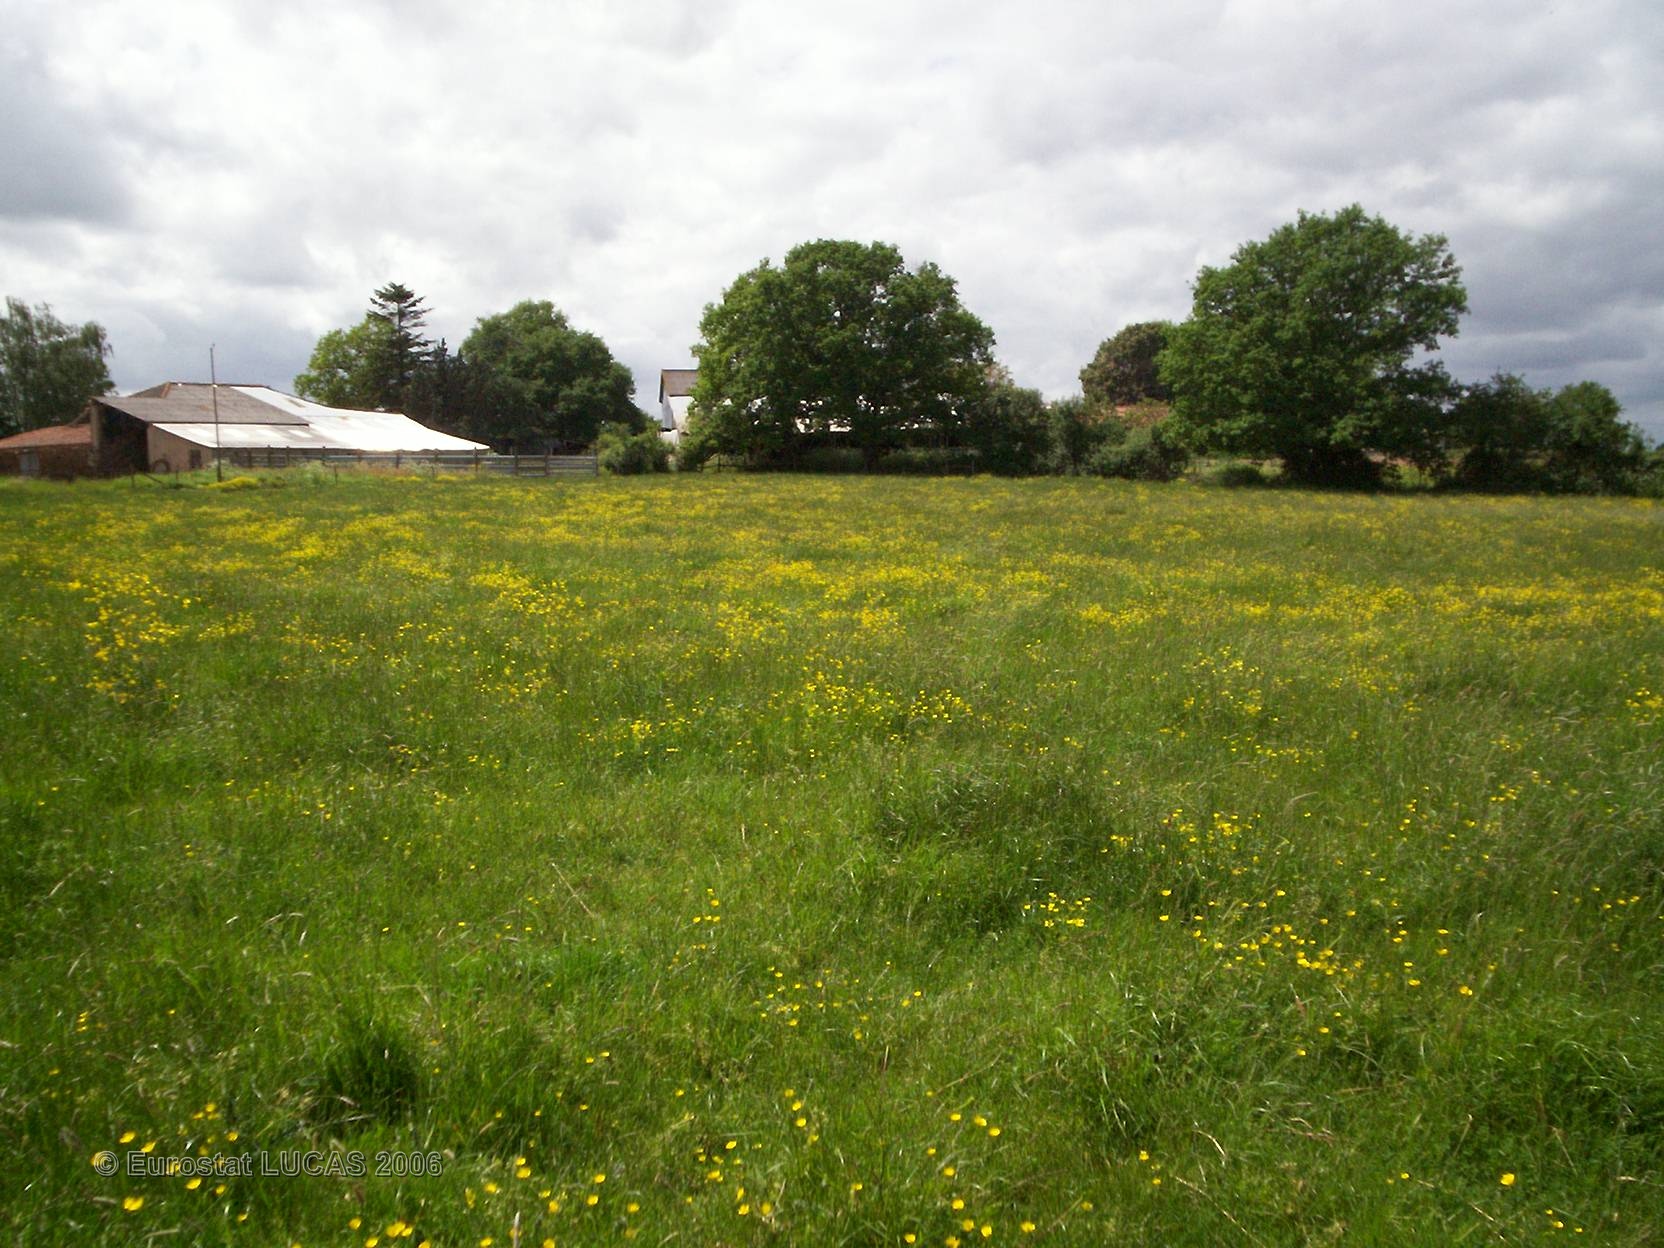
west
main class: Grassland
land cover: Grassland with sparse tree/shrub cover
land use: Agriculture (excluding fallow land and kitchen gardens)
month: May
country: FR
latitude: 47.2644
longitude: -1.0720
